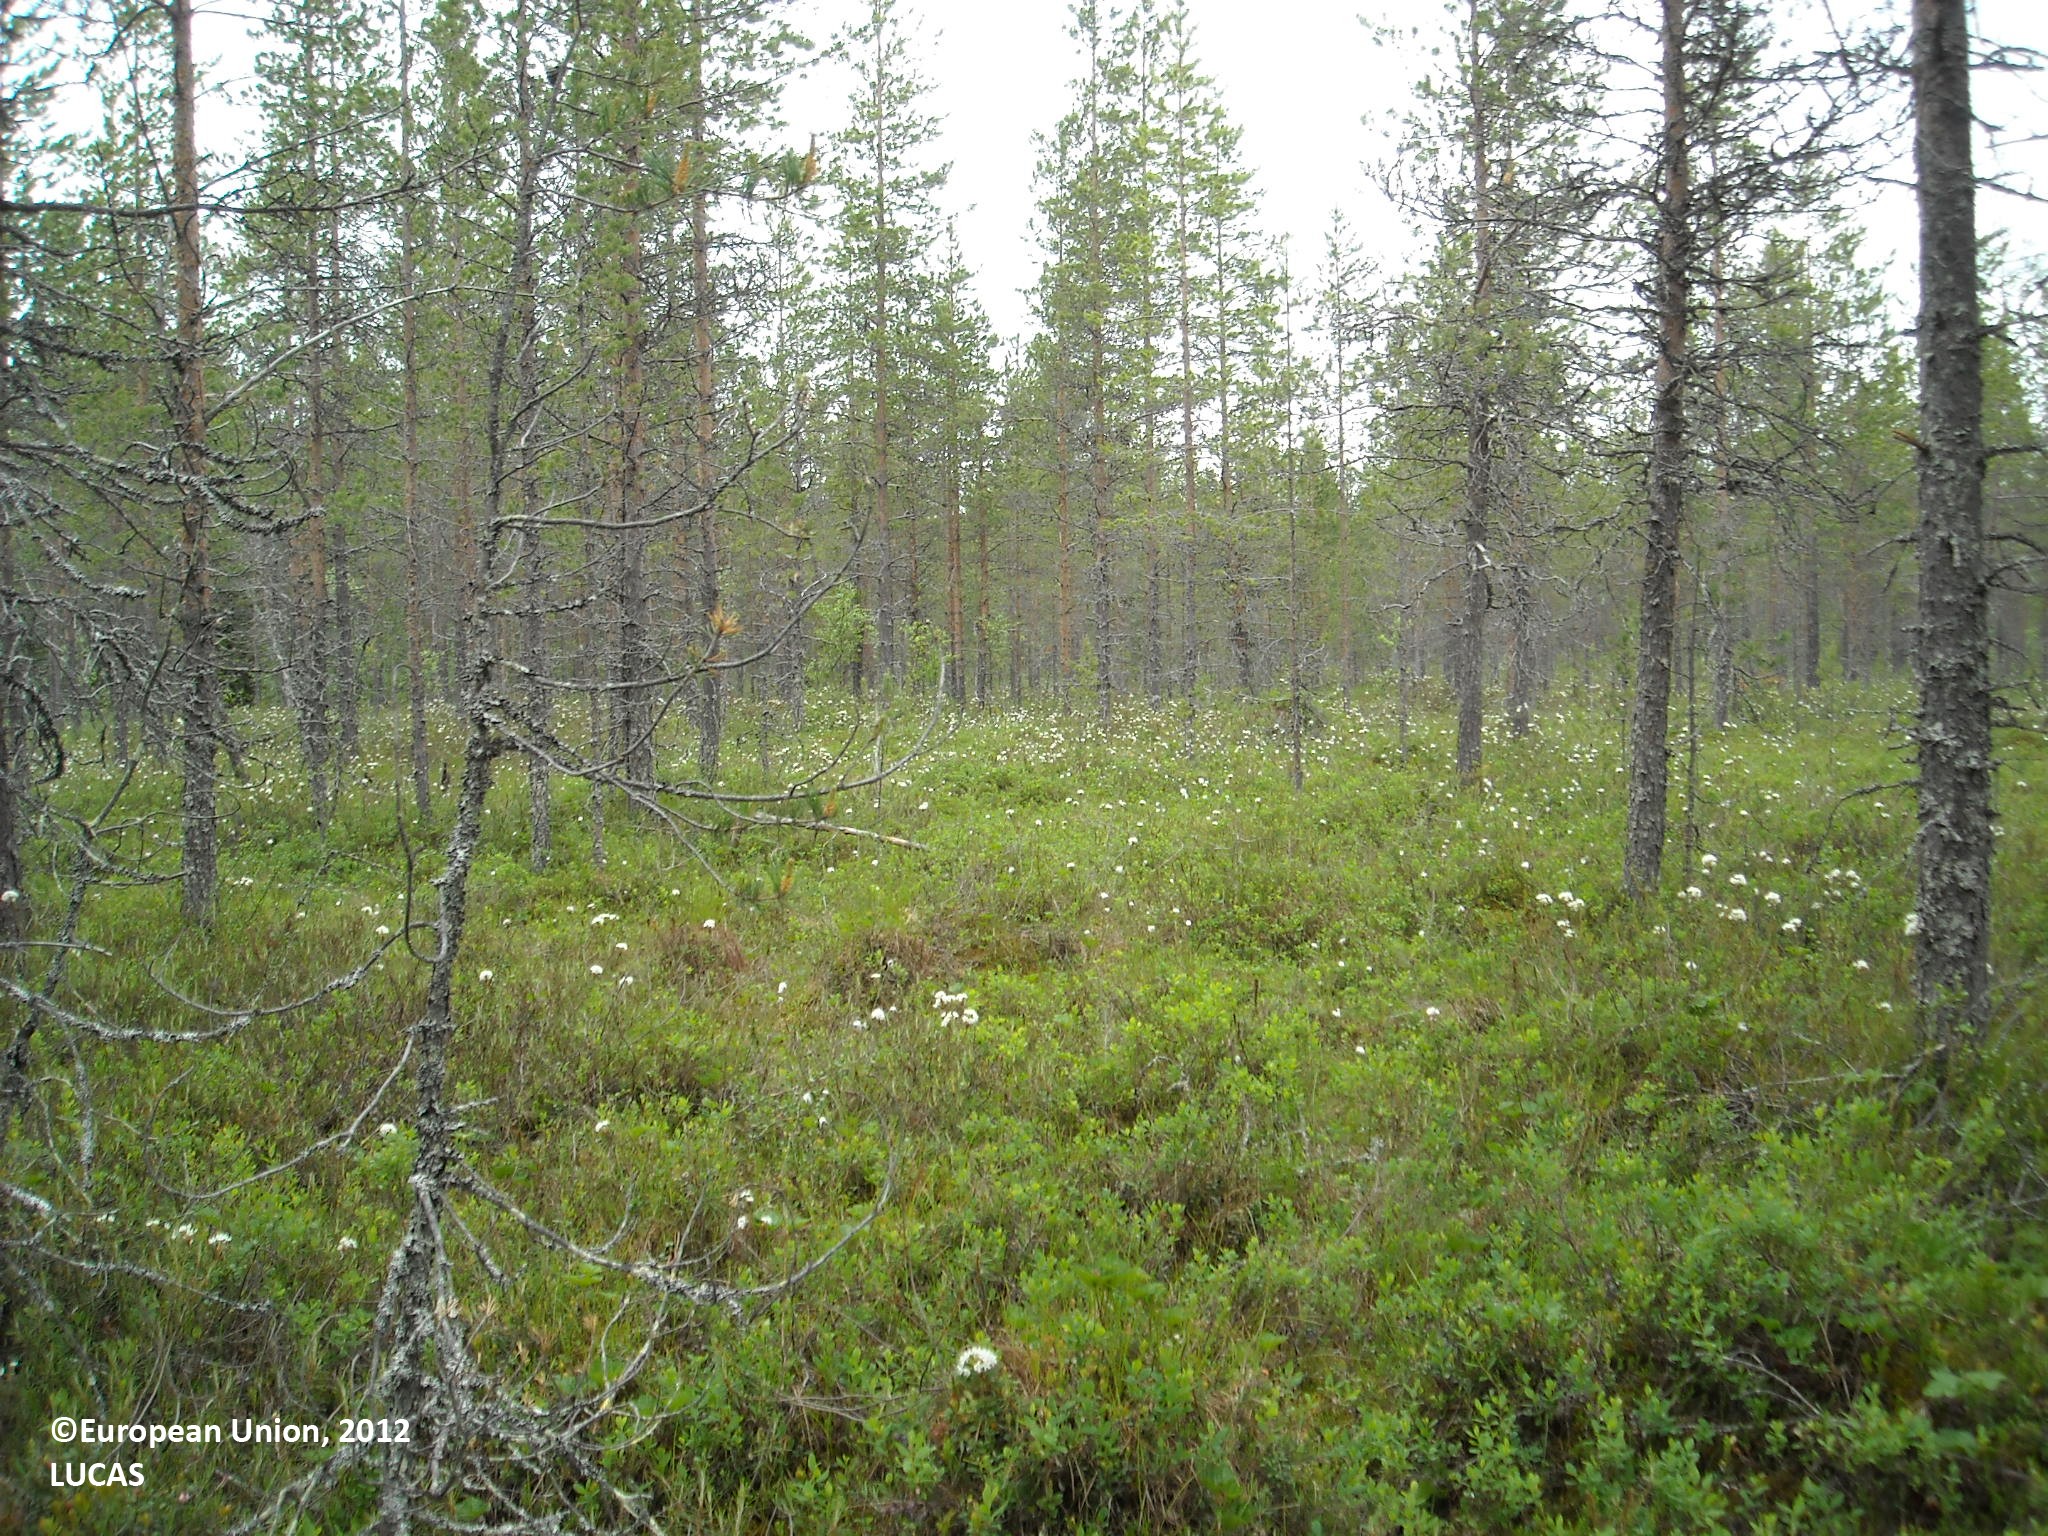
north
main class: Woodland
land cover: Pine dominated coniferous woodland
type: mire and swamp forests
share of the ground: 50 - 75 %
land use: Forestry
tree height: > 5 m
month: June
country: FI
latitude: 64.8474
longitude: 27.4925
